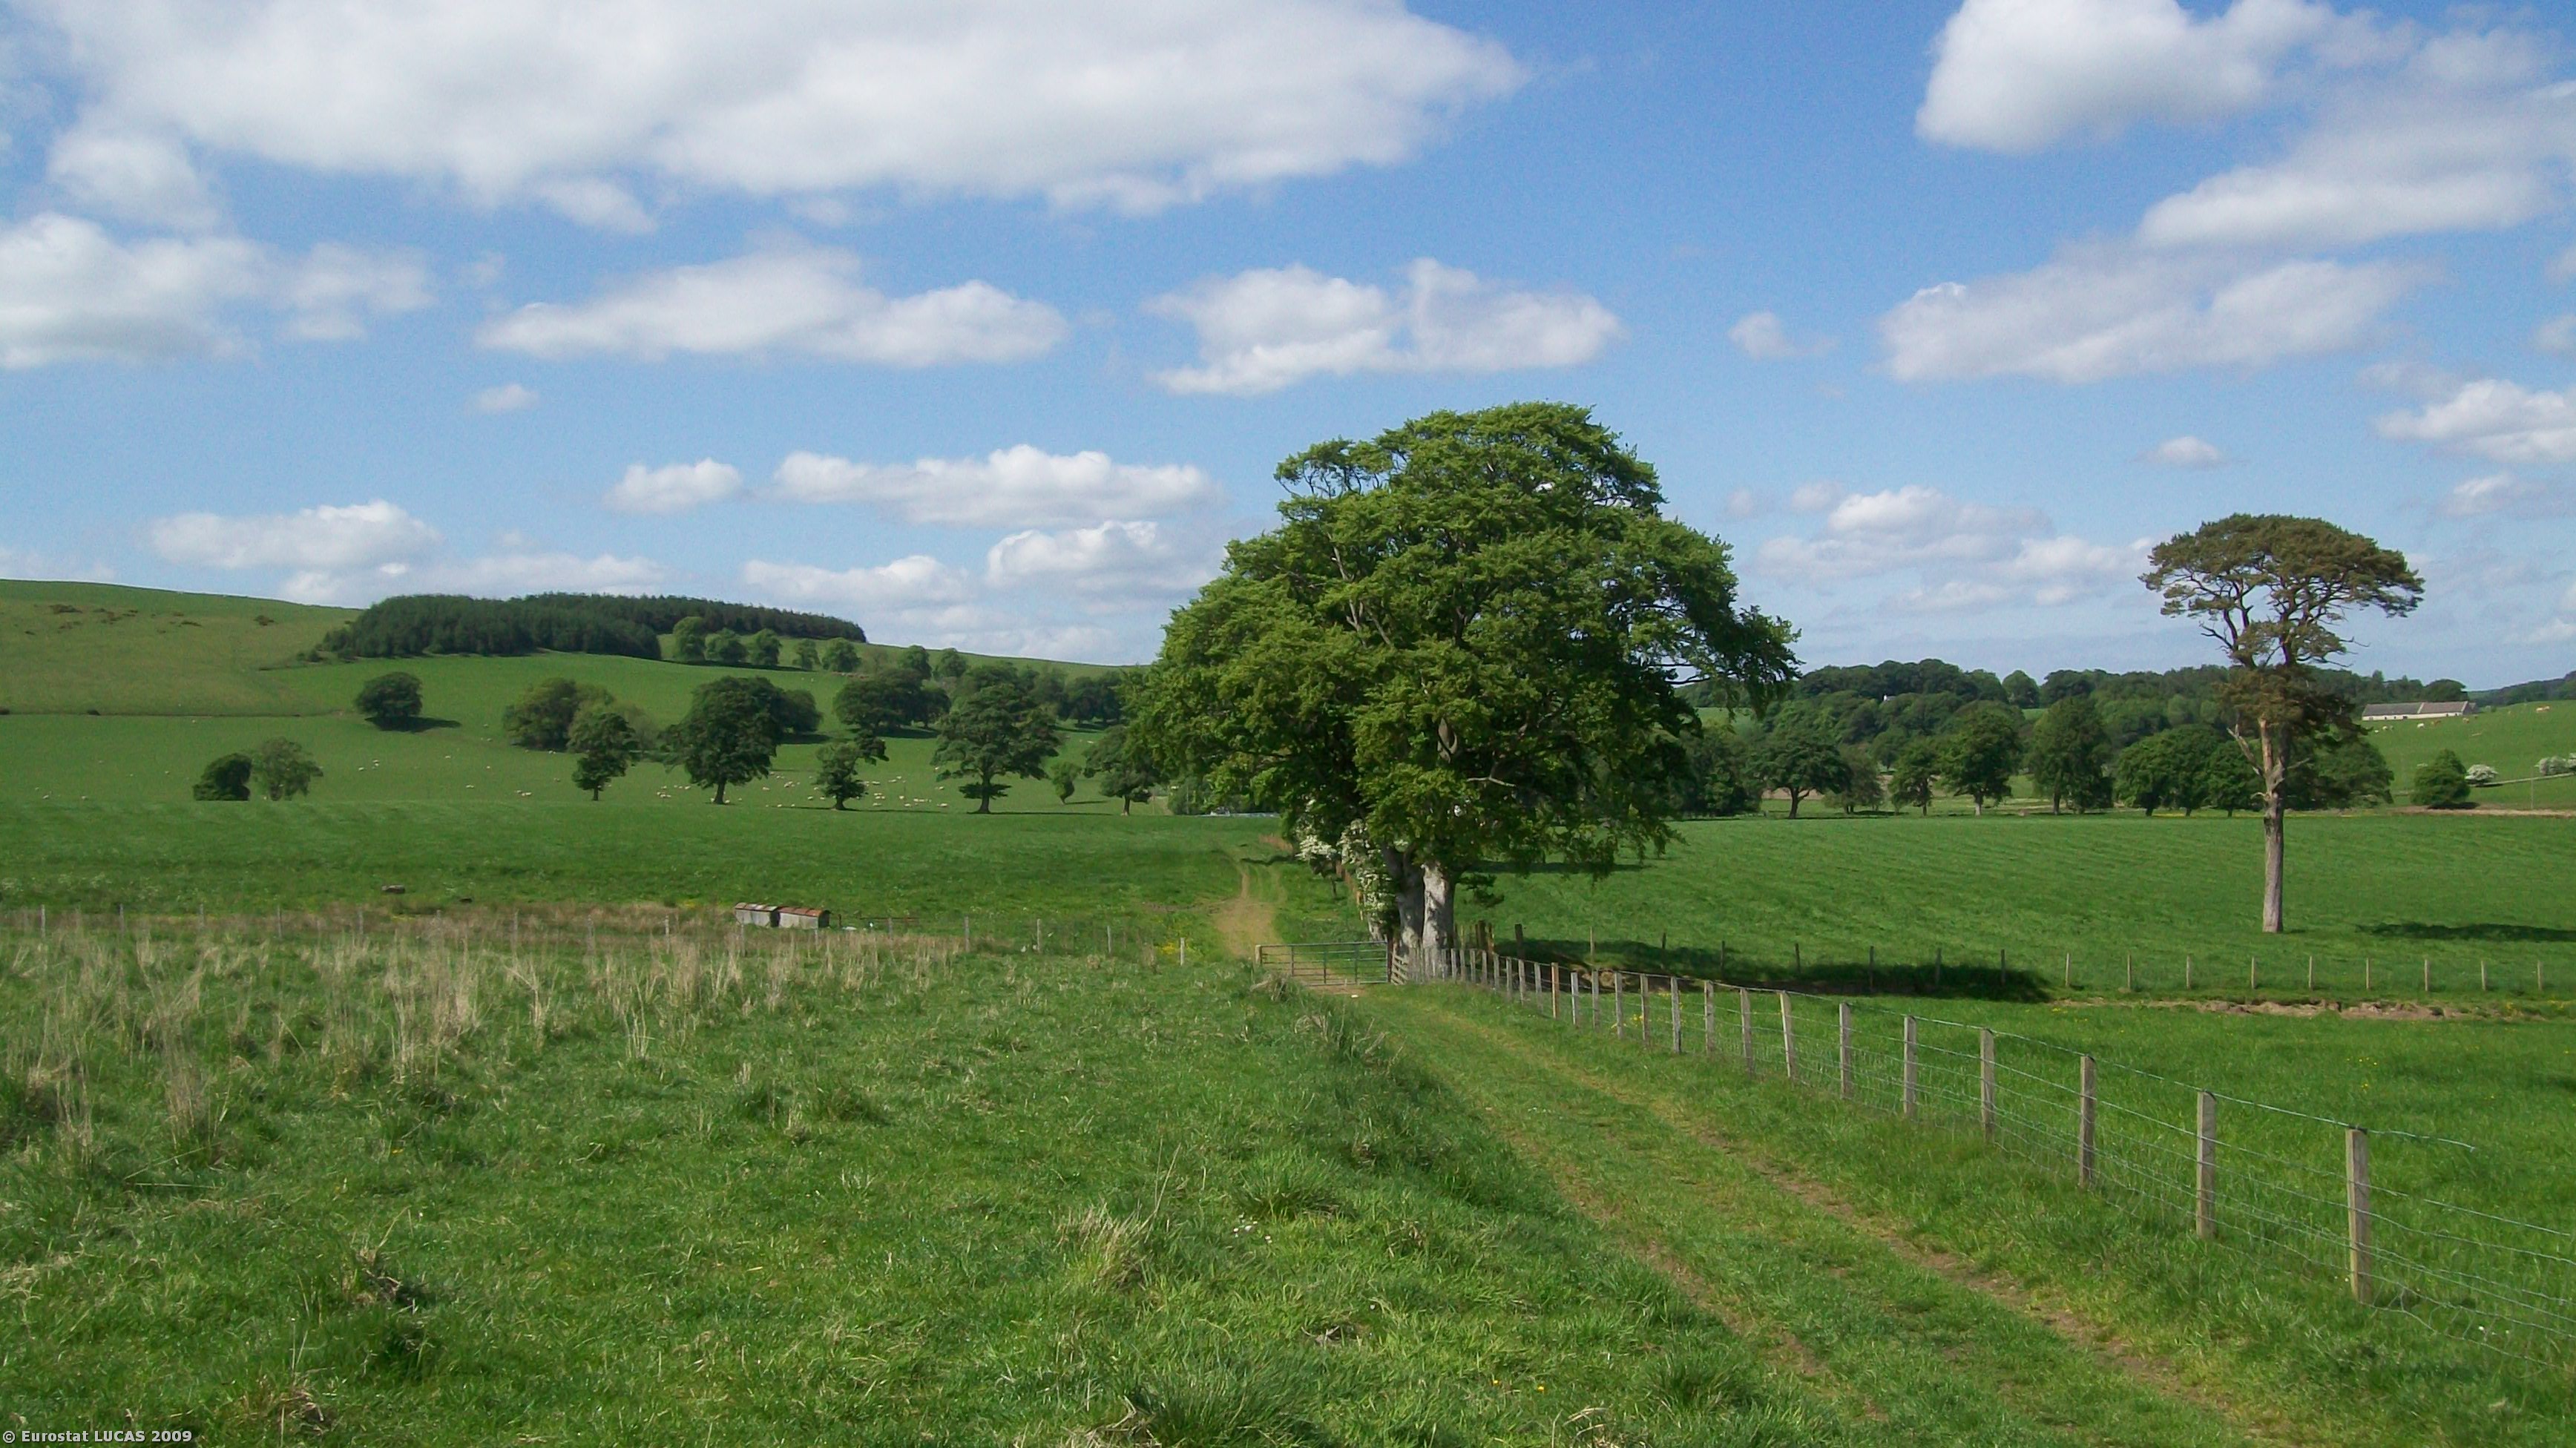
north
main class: Shrubland
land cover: Shrubland without tree cover
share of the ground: > 75 %
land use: Agriculture (excluding fallow land and kitchen gardens)
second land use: Forestry
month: June
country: GB
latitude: 55.6308
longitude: -3.5325
